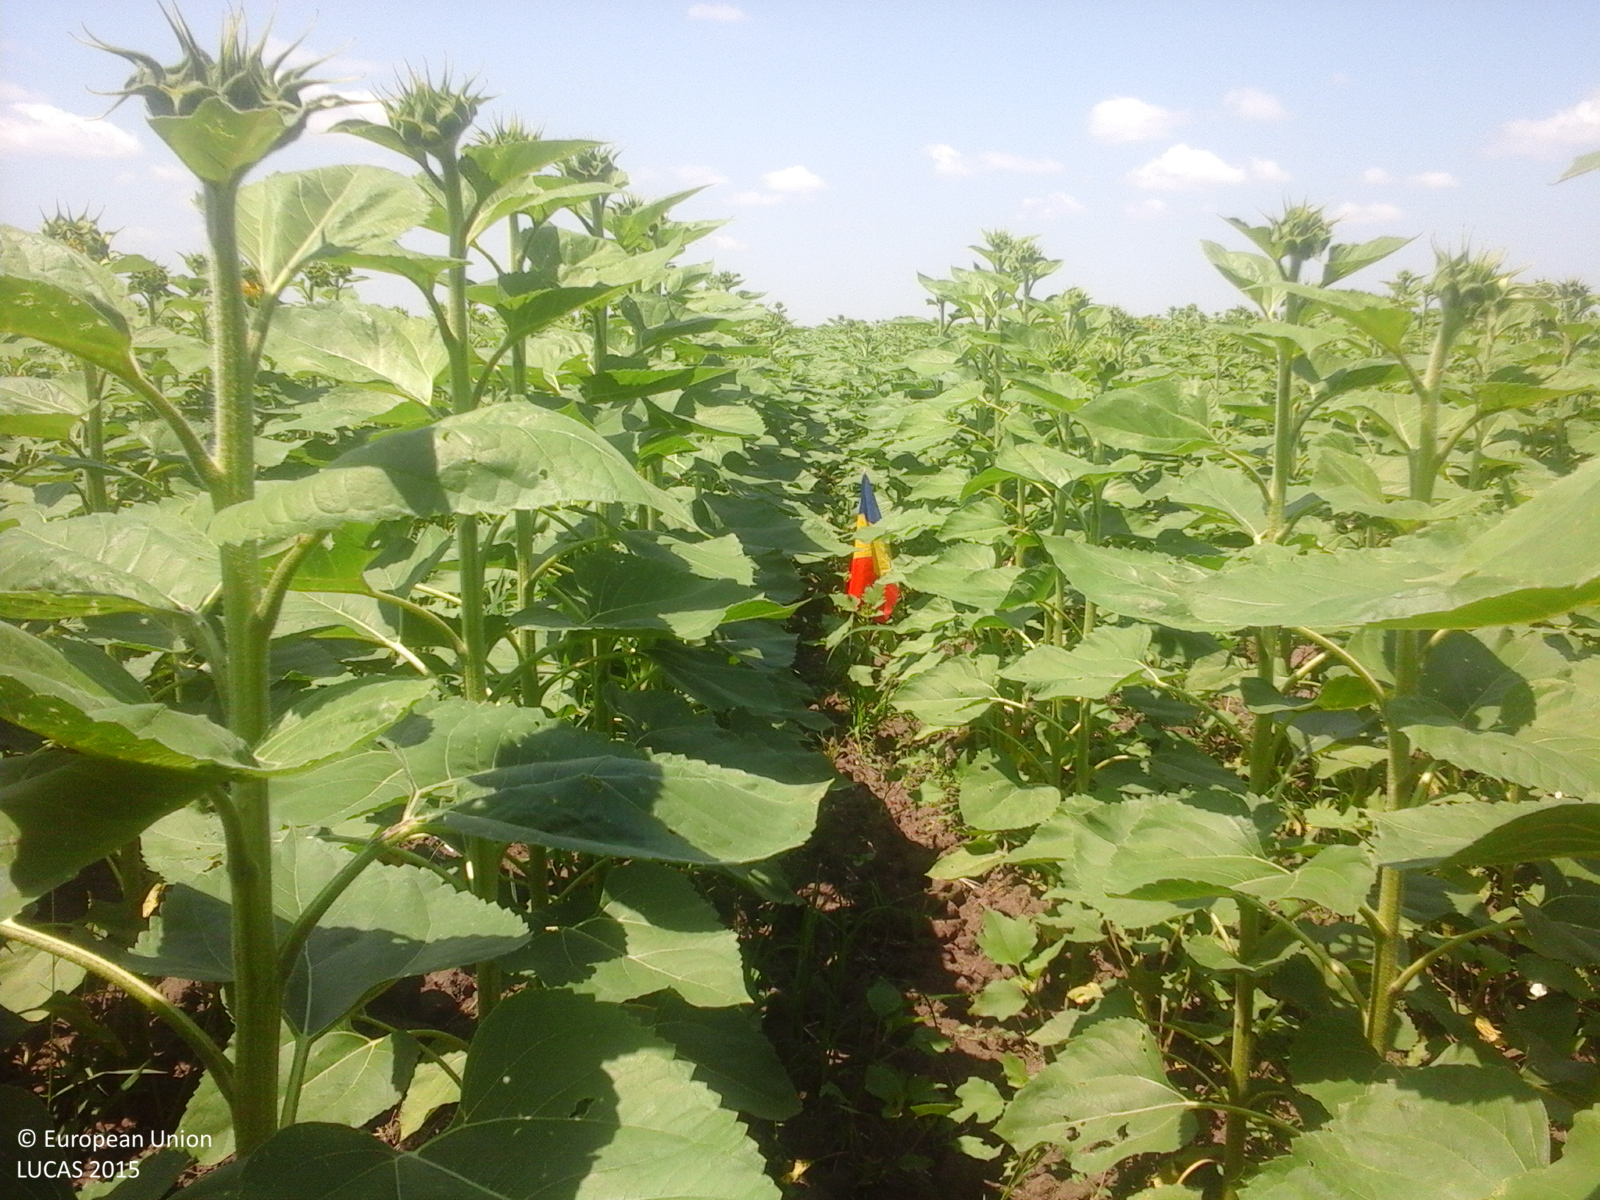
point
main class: Cropland
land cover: Sunflower
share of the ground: > 75 %
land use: Agriculture (excluding fallow land and kitchen gardens)
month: July
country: RO
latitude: 44.1148
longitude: 24.0920
